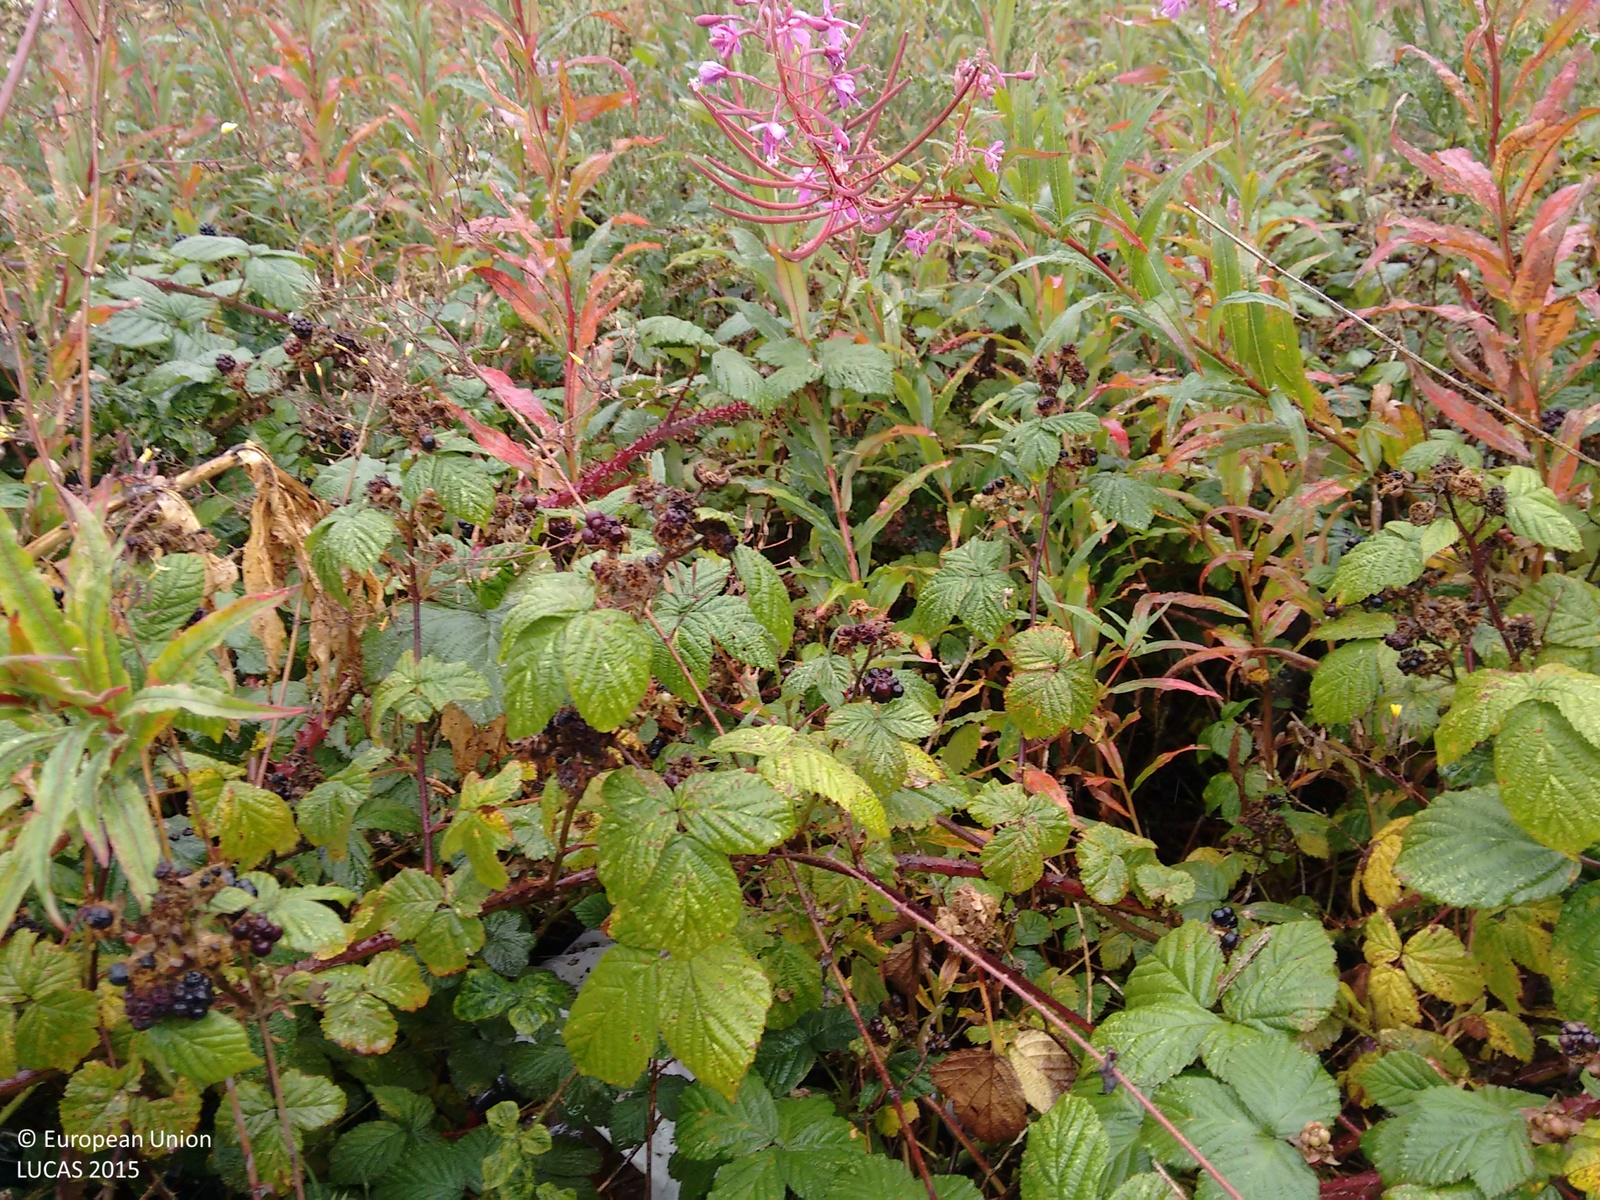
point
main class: Shrubland
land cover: Shrubland without tree cover
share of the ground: > 75 %
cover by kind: shrubs 100 %
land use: Semi-natural and natural areas not in use
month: September
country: GB
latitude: 53.0540
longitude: -3.0706
